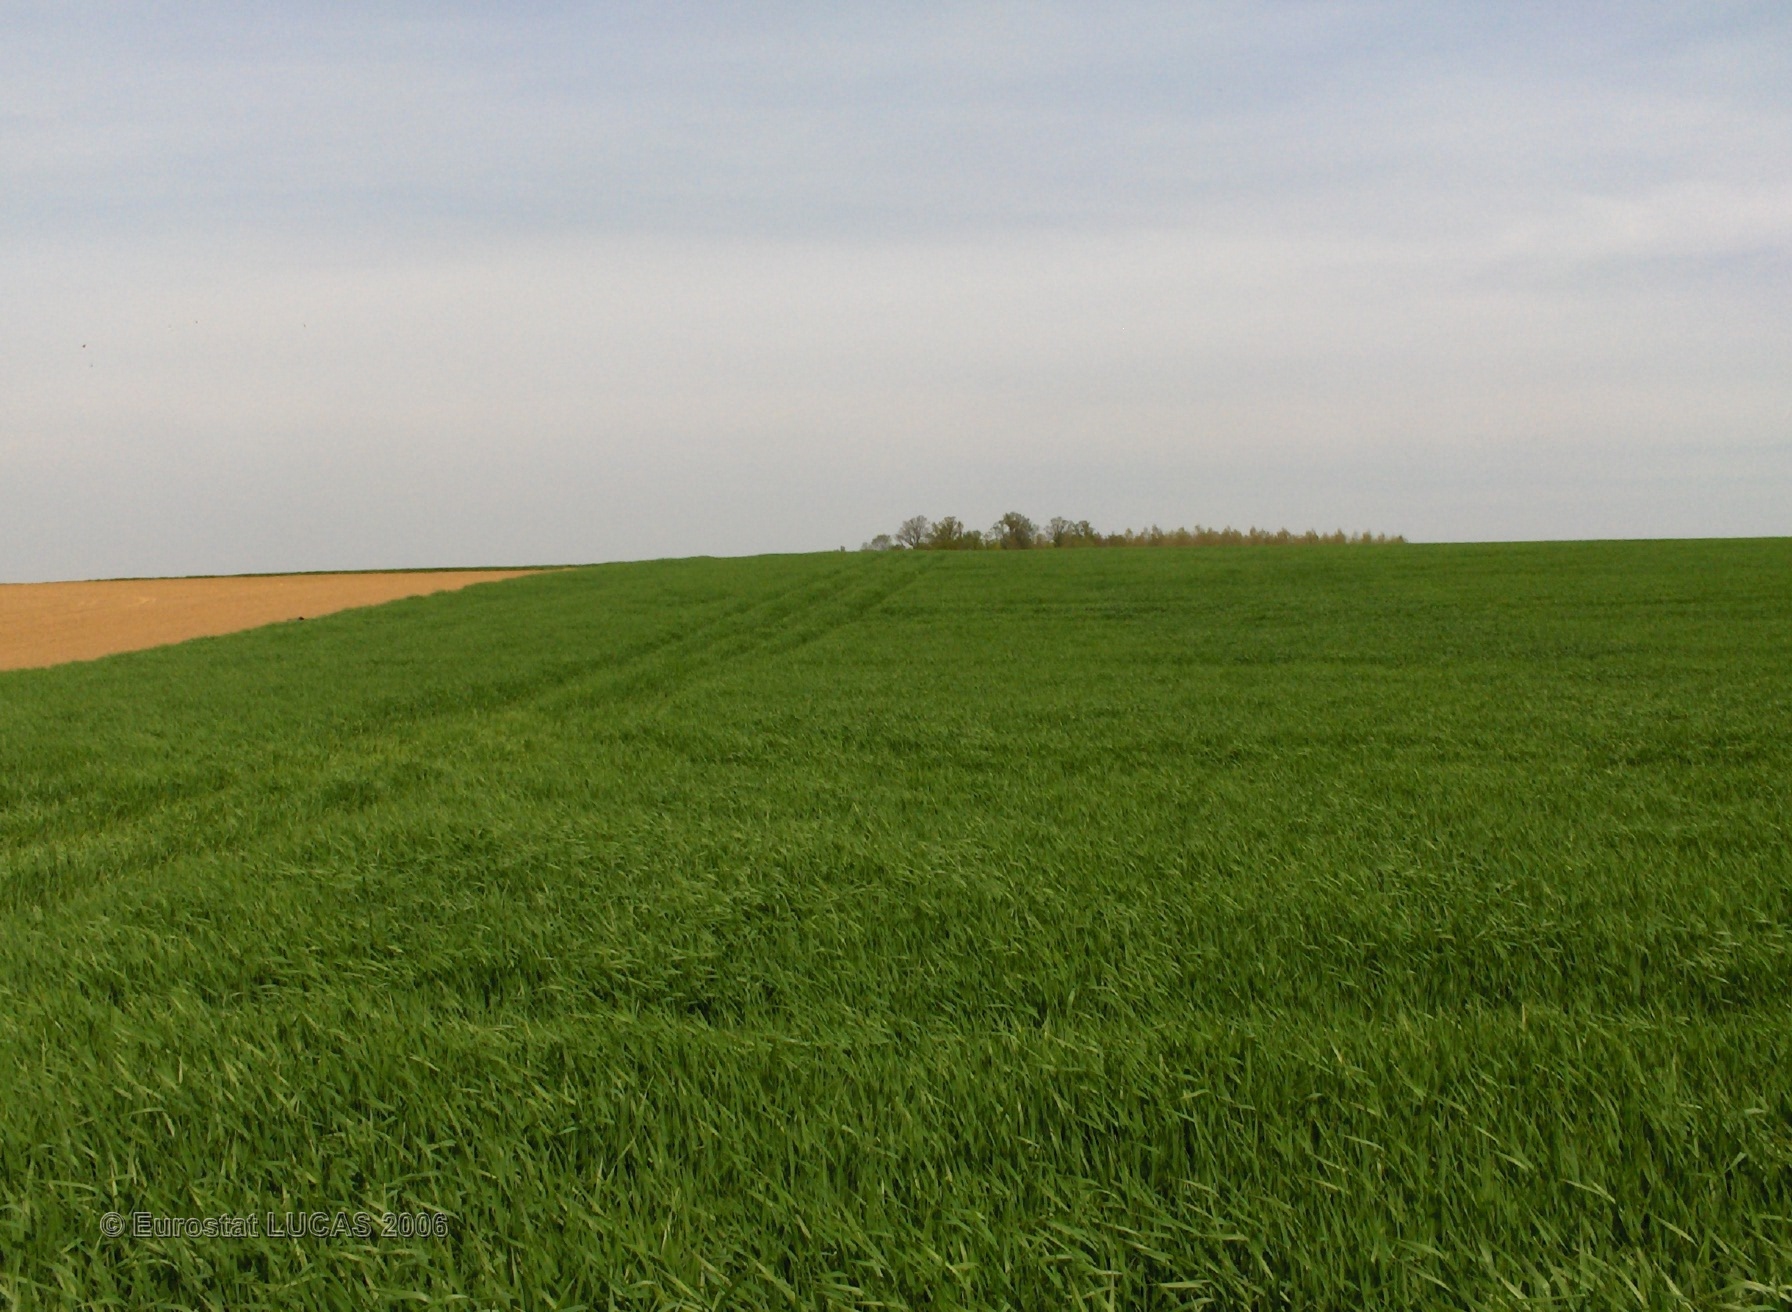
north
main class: Cropland
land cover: Barley
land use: Agriculture (excluding fallow land and kitchen gardens)
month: May
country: BE
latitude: 50.7159
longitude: 5.2530
